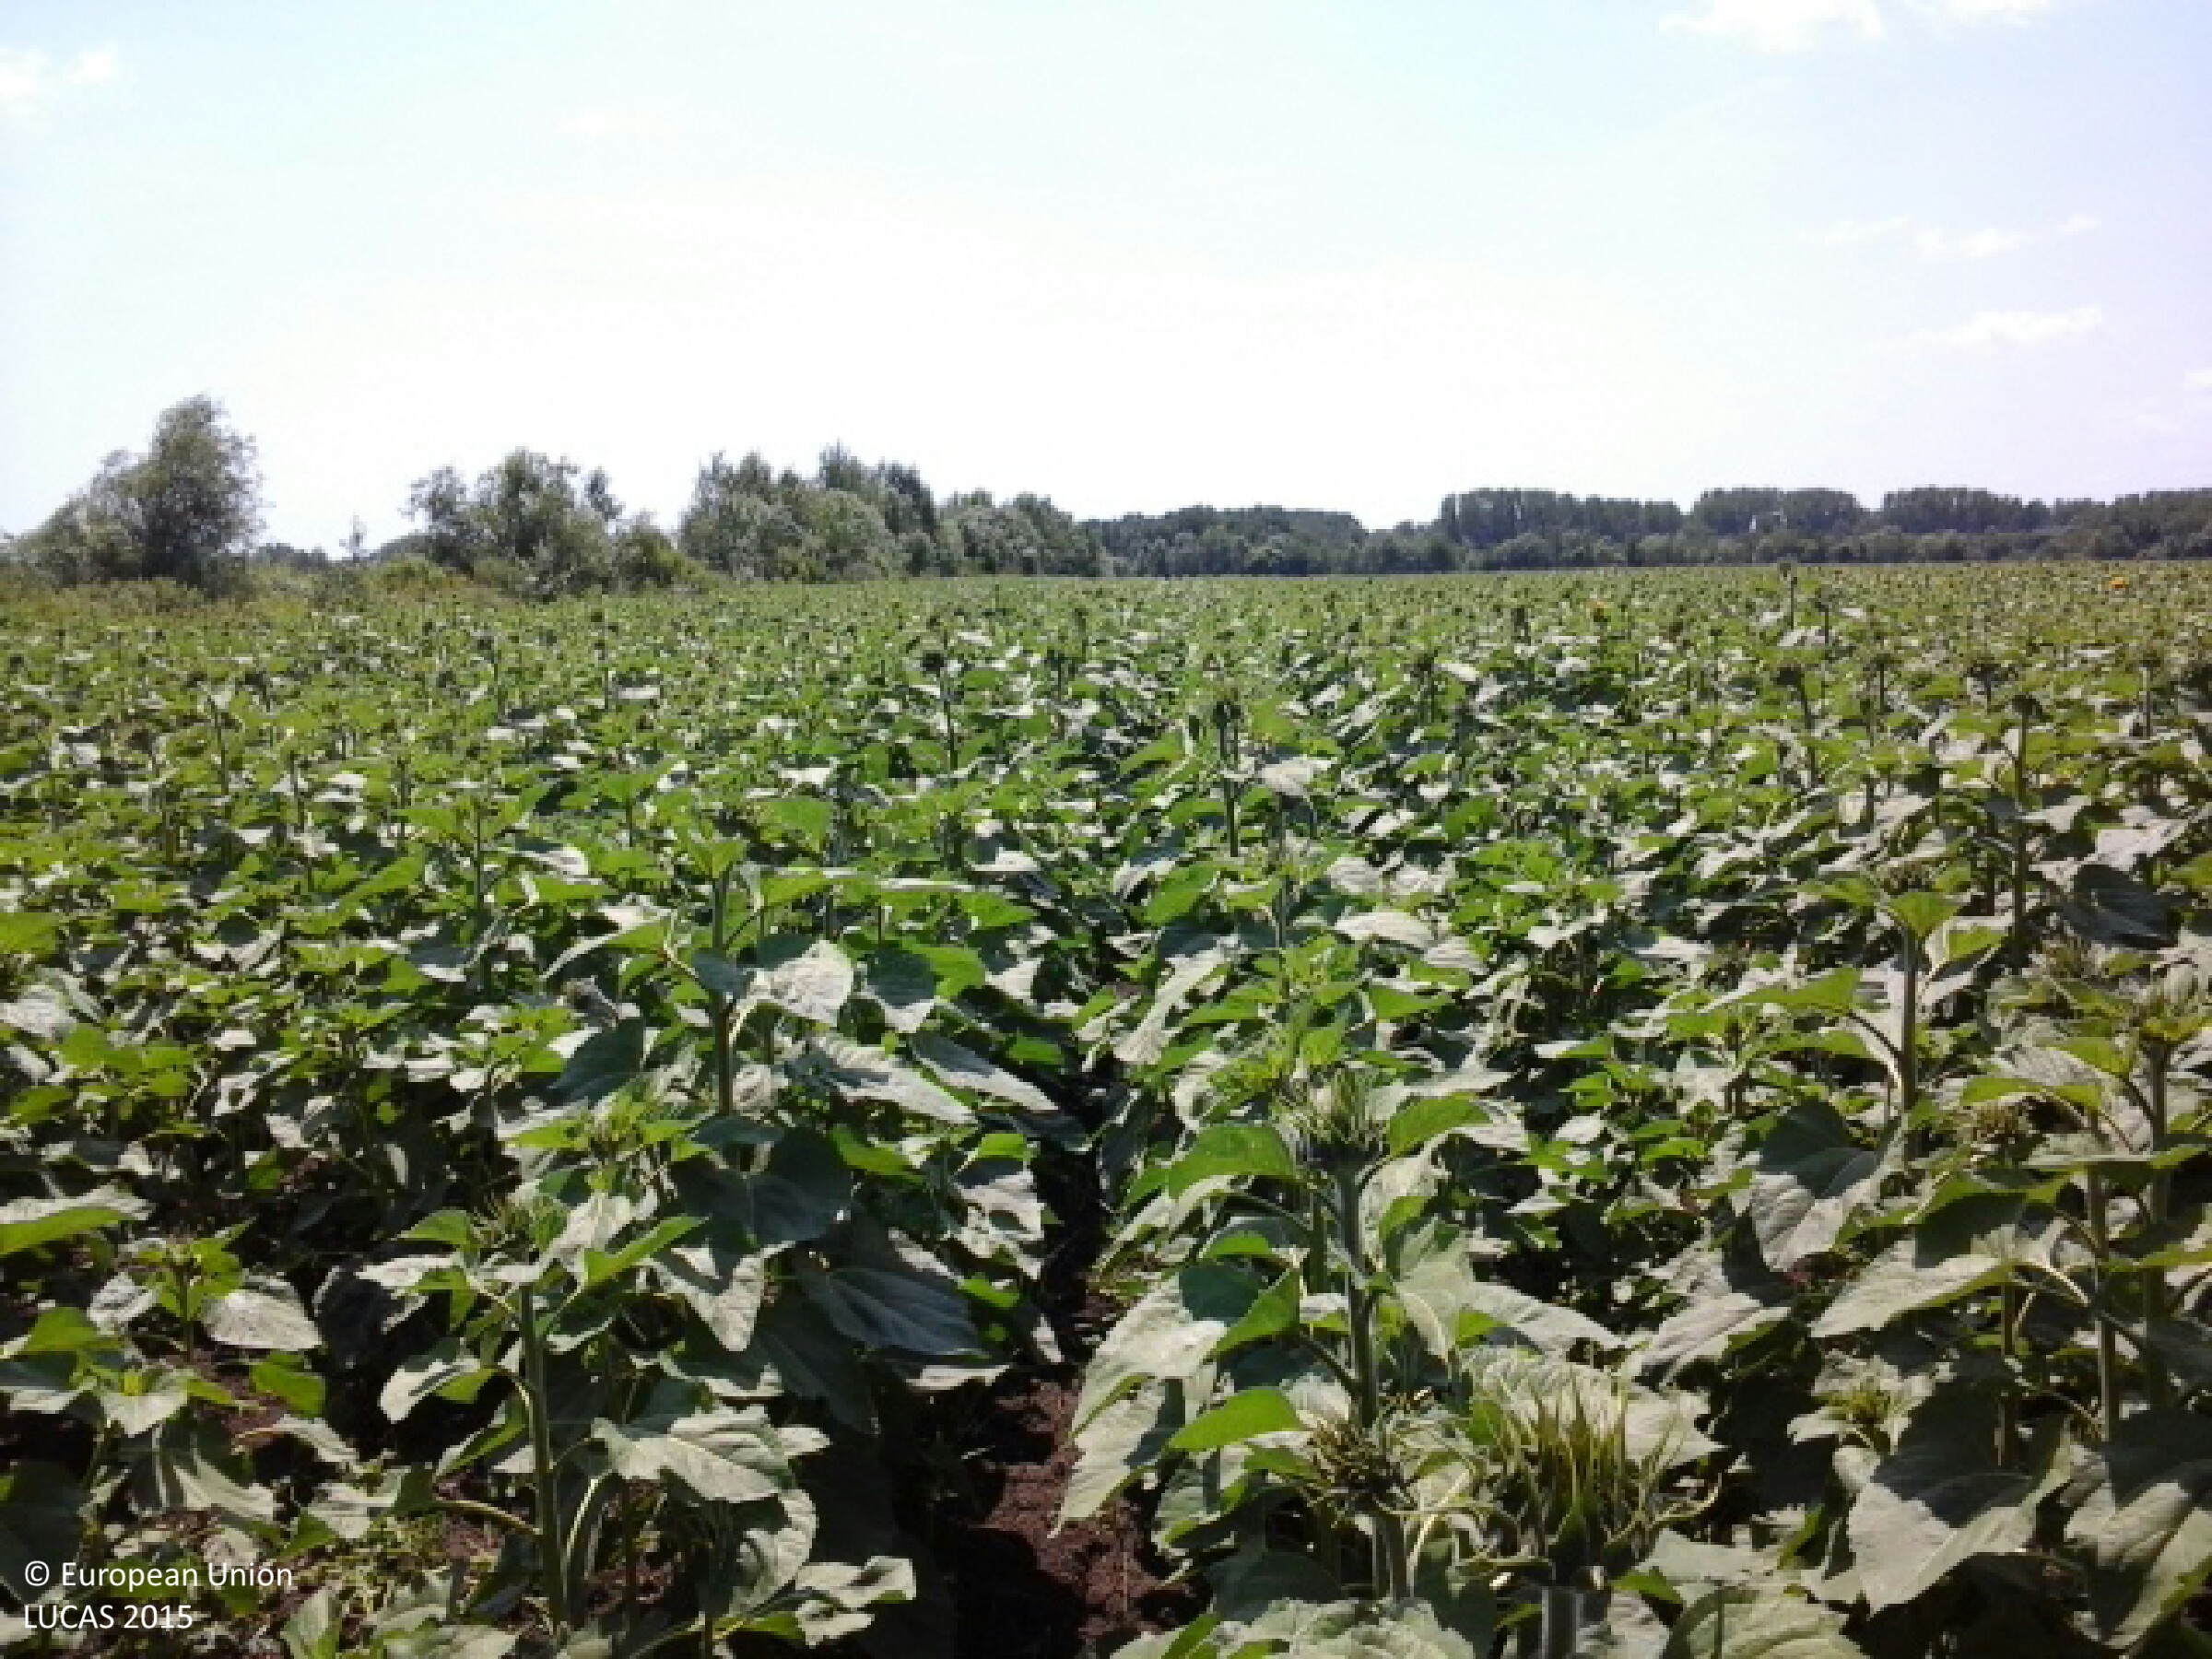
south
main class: Cropland
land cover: Sunflower
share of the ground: > 75 %
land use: Agriculture (excluding fallow land and kitchen gardens)
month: July
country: HU
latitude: 48.2547
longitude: 21.5083
